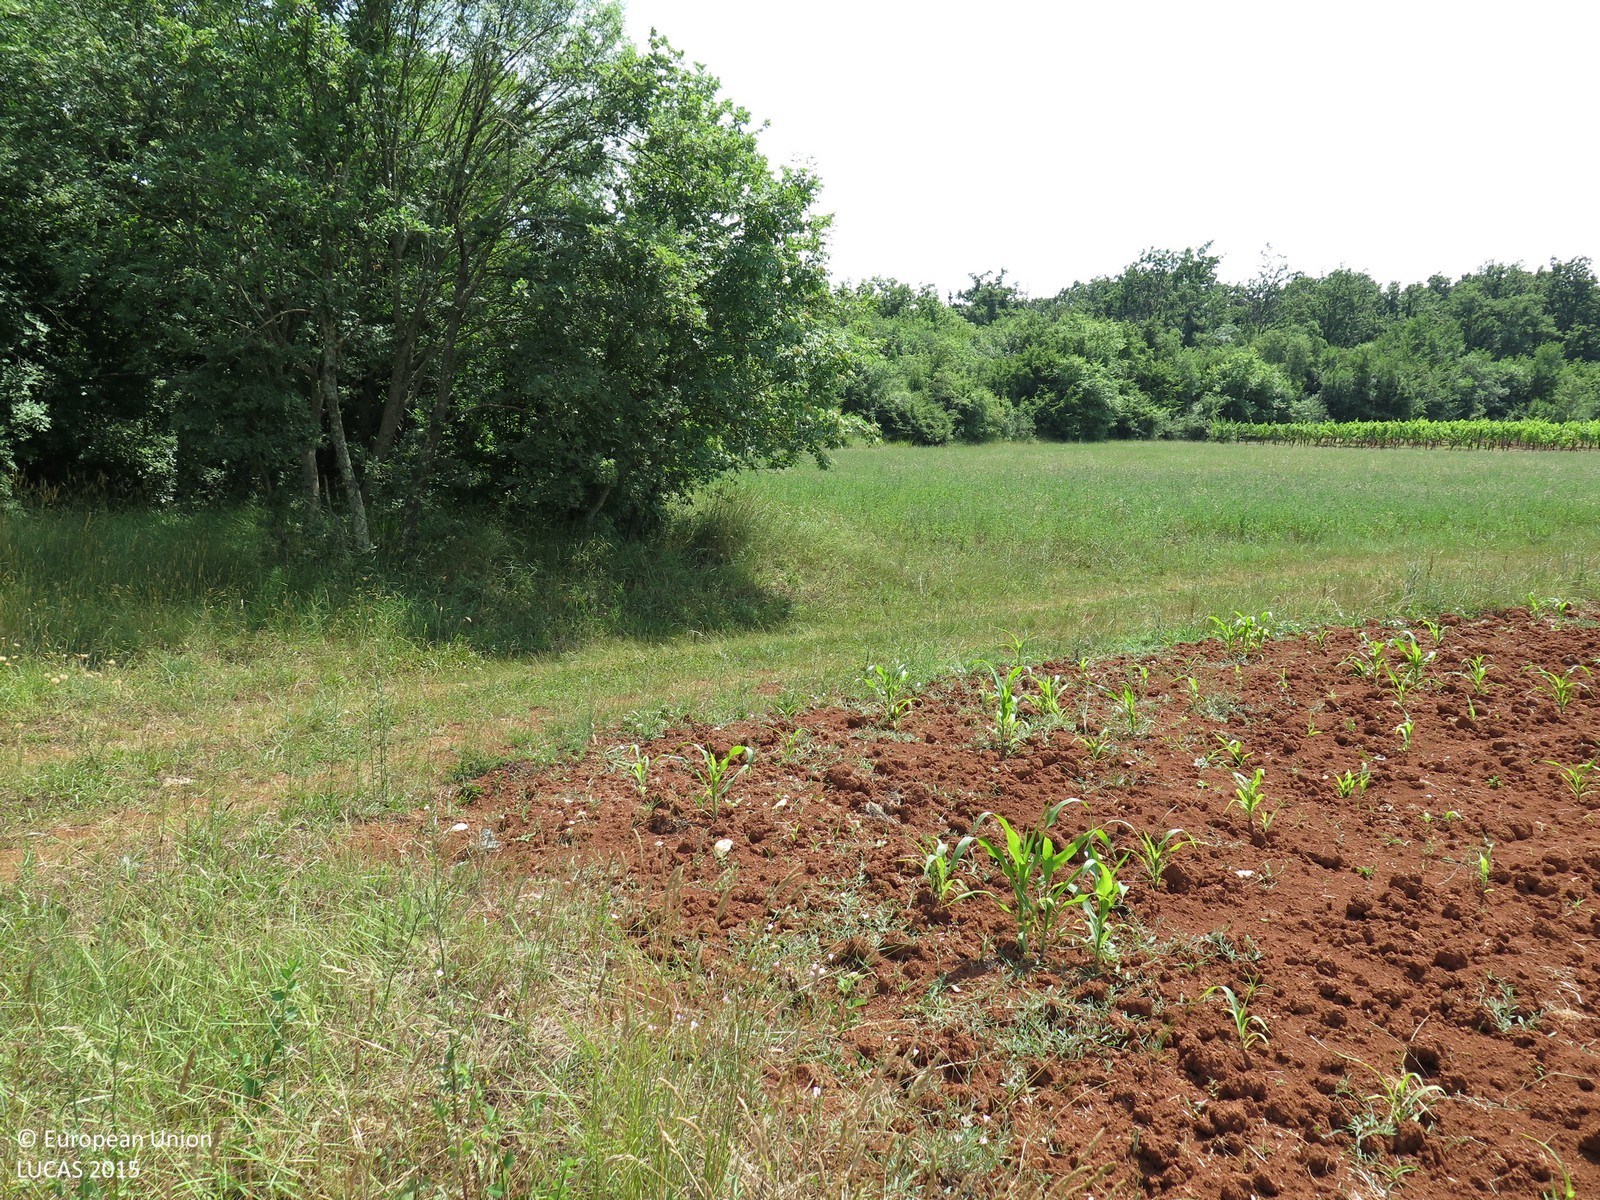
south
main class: Grassland
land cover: Grassland without tree/shrub cover
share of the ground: > 75 %
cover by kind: herbaceous plants 100 %
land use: Abandoned areas
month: June
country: HR
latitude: 45.1691
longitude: 13.6972
